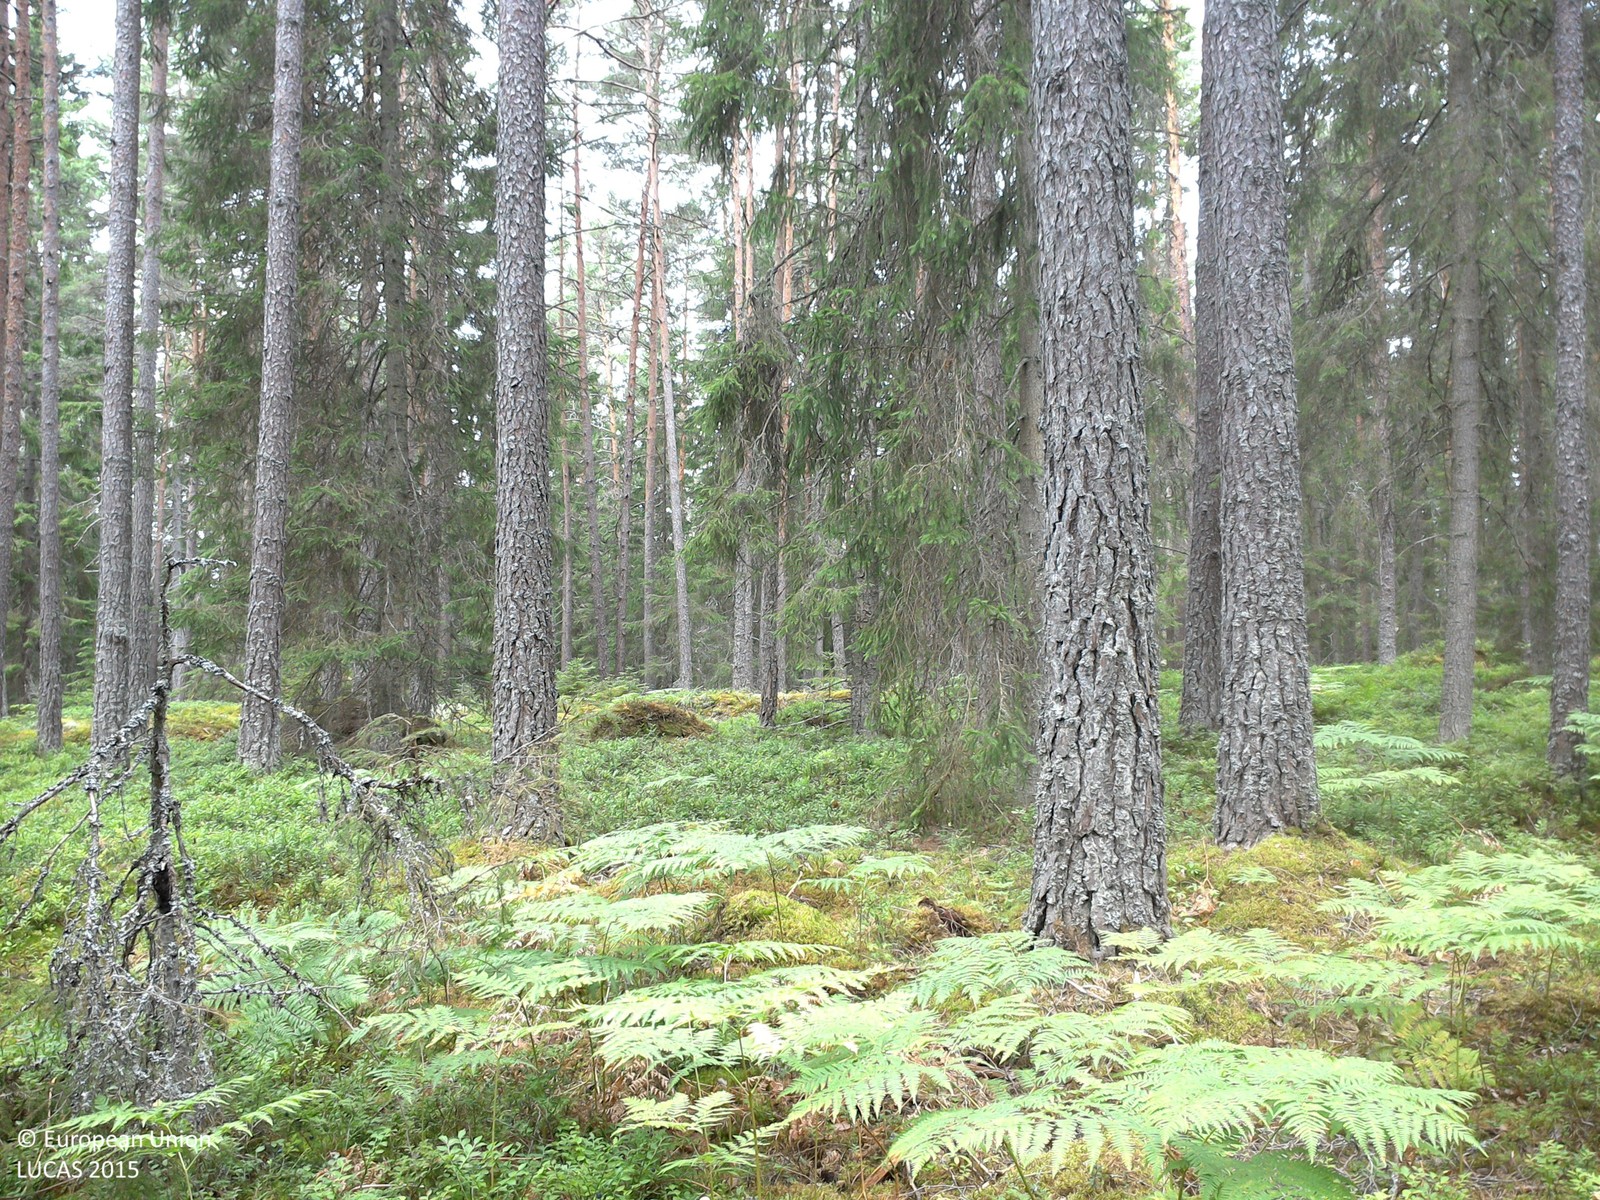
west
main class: Woodland
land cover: Pine dominated coniferous woodland
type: boreal forest
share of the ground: 50 - 75 %
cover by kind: coniferous forest trees 50 %, shrubs 30 %, herbaceous plants 10 %, lichens and mosses 10 %
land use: Forestry
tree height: > 5 m
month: July
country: SE
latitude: 57.7594
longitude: 16.0308
